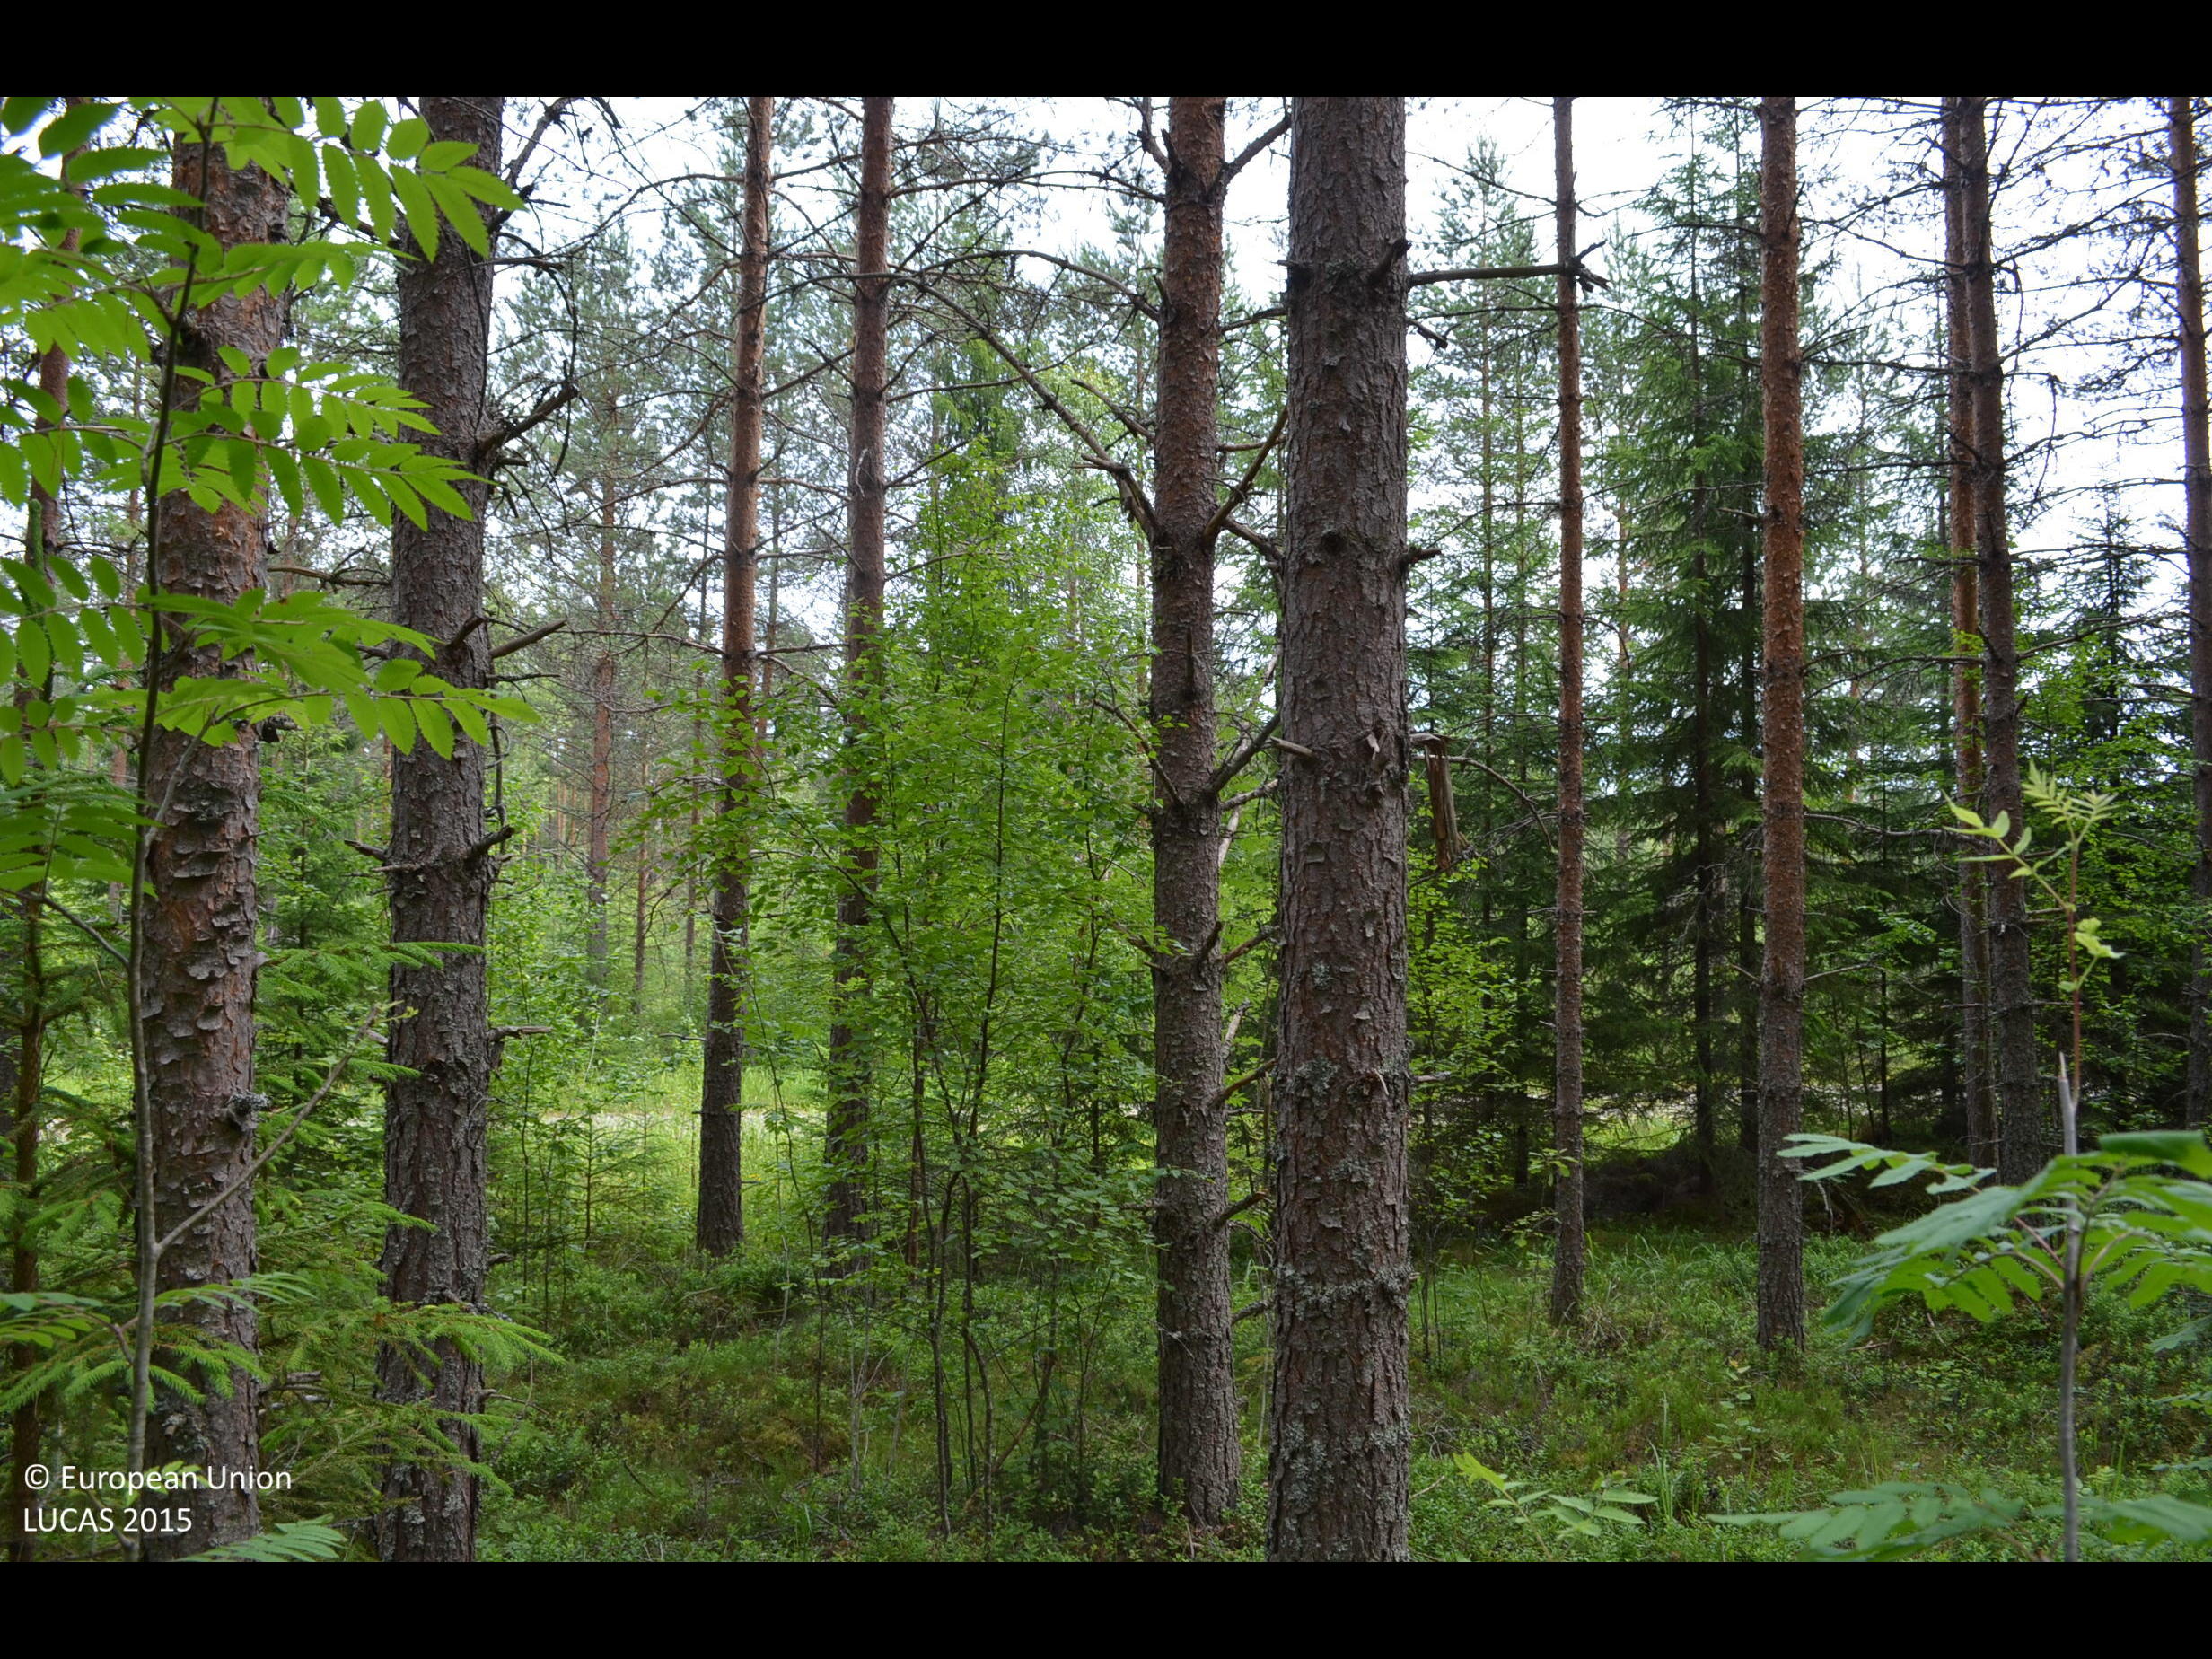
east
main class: Woodland
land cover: Pine dominated coniferous woodland
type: boreal forest
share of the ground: > 75 %
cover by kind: coniferous forest trees 75 %, shrubs 20 %, broadleaved forest trees 5 %
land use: Forestry
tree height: > 5 m
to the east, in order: Pine dominated coniferous woodland; Ditches and canals; Shrubland with sparse tree cover; Grass margins; Tracks; Grass margins; Pine dominated coniferous woodland; Other mixed woodland; Ditches and canals; Pine dominated mixed woodland; Spruce dominated coniferous woodland; Pine dominated coniferous woodland; Other coniferous woodland; Ditches and canals; Other mixed woodland
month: July
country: FI
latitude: 62.1806
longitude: 23.5390
